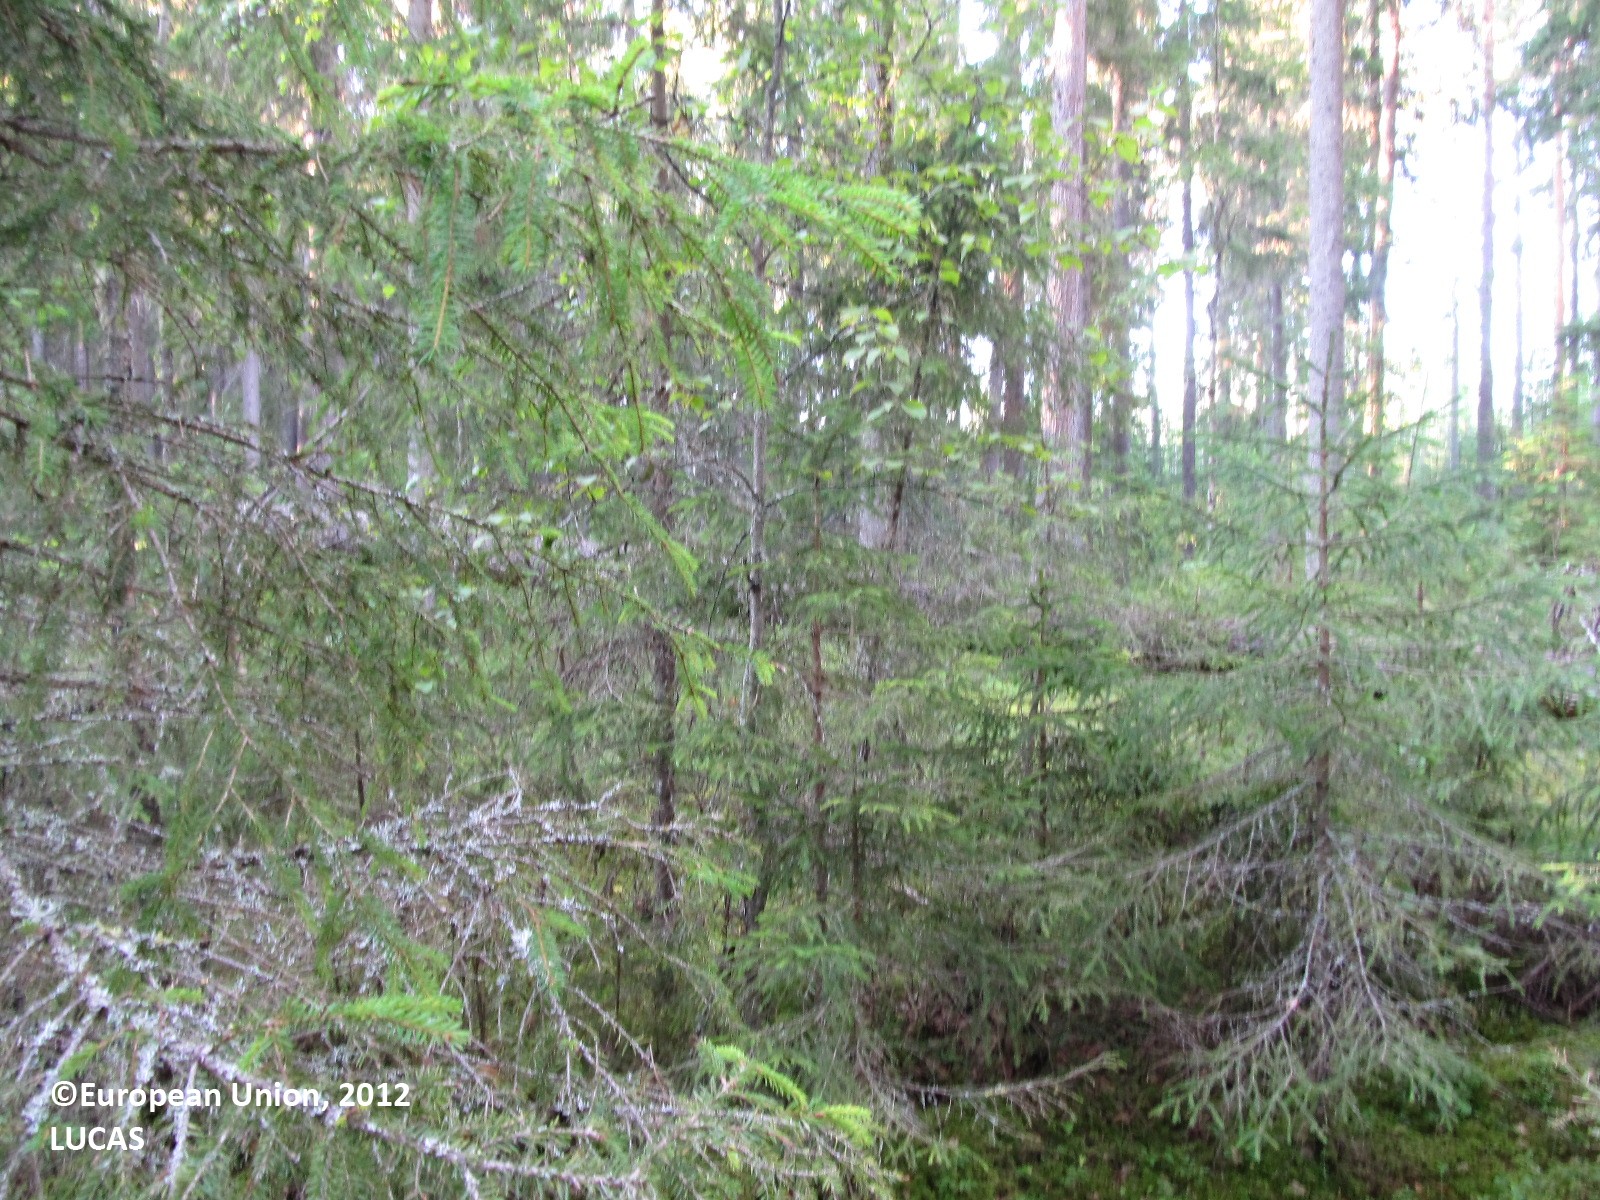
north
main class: Woodland
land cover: Other coniferous woodland
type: boreal forest
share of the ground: 50 - 75 %
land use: Forestry
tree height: > 5 m
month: August
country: FI
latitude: 62.1057
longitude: 27.7098
